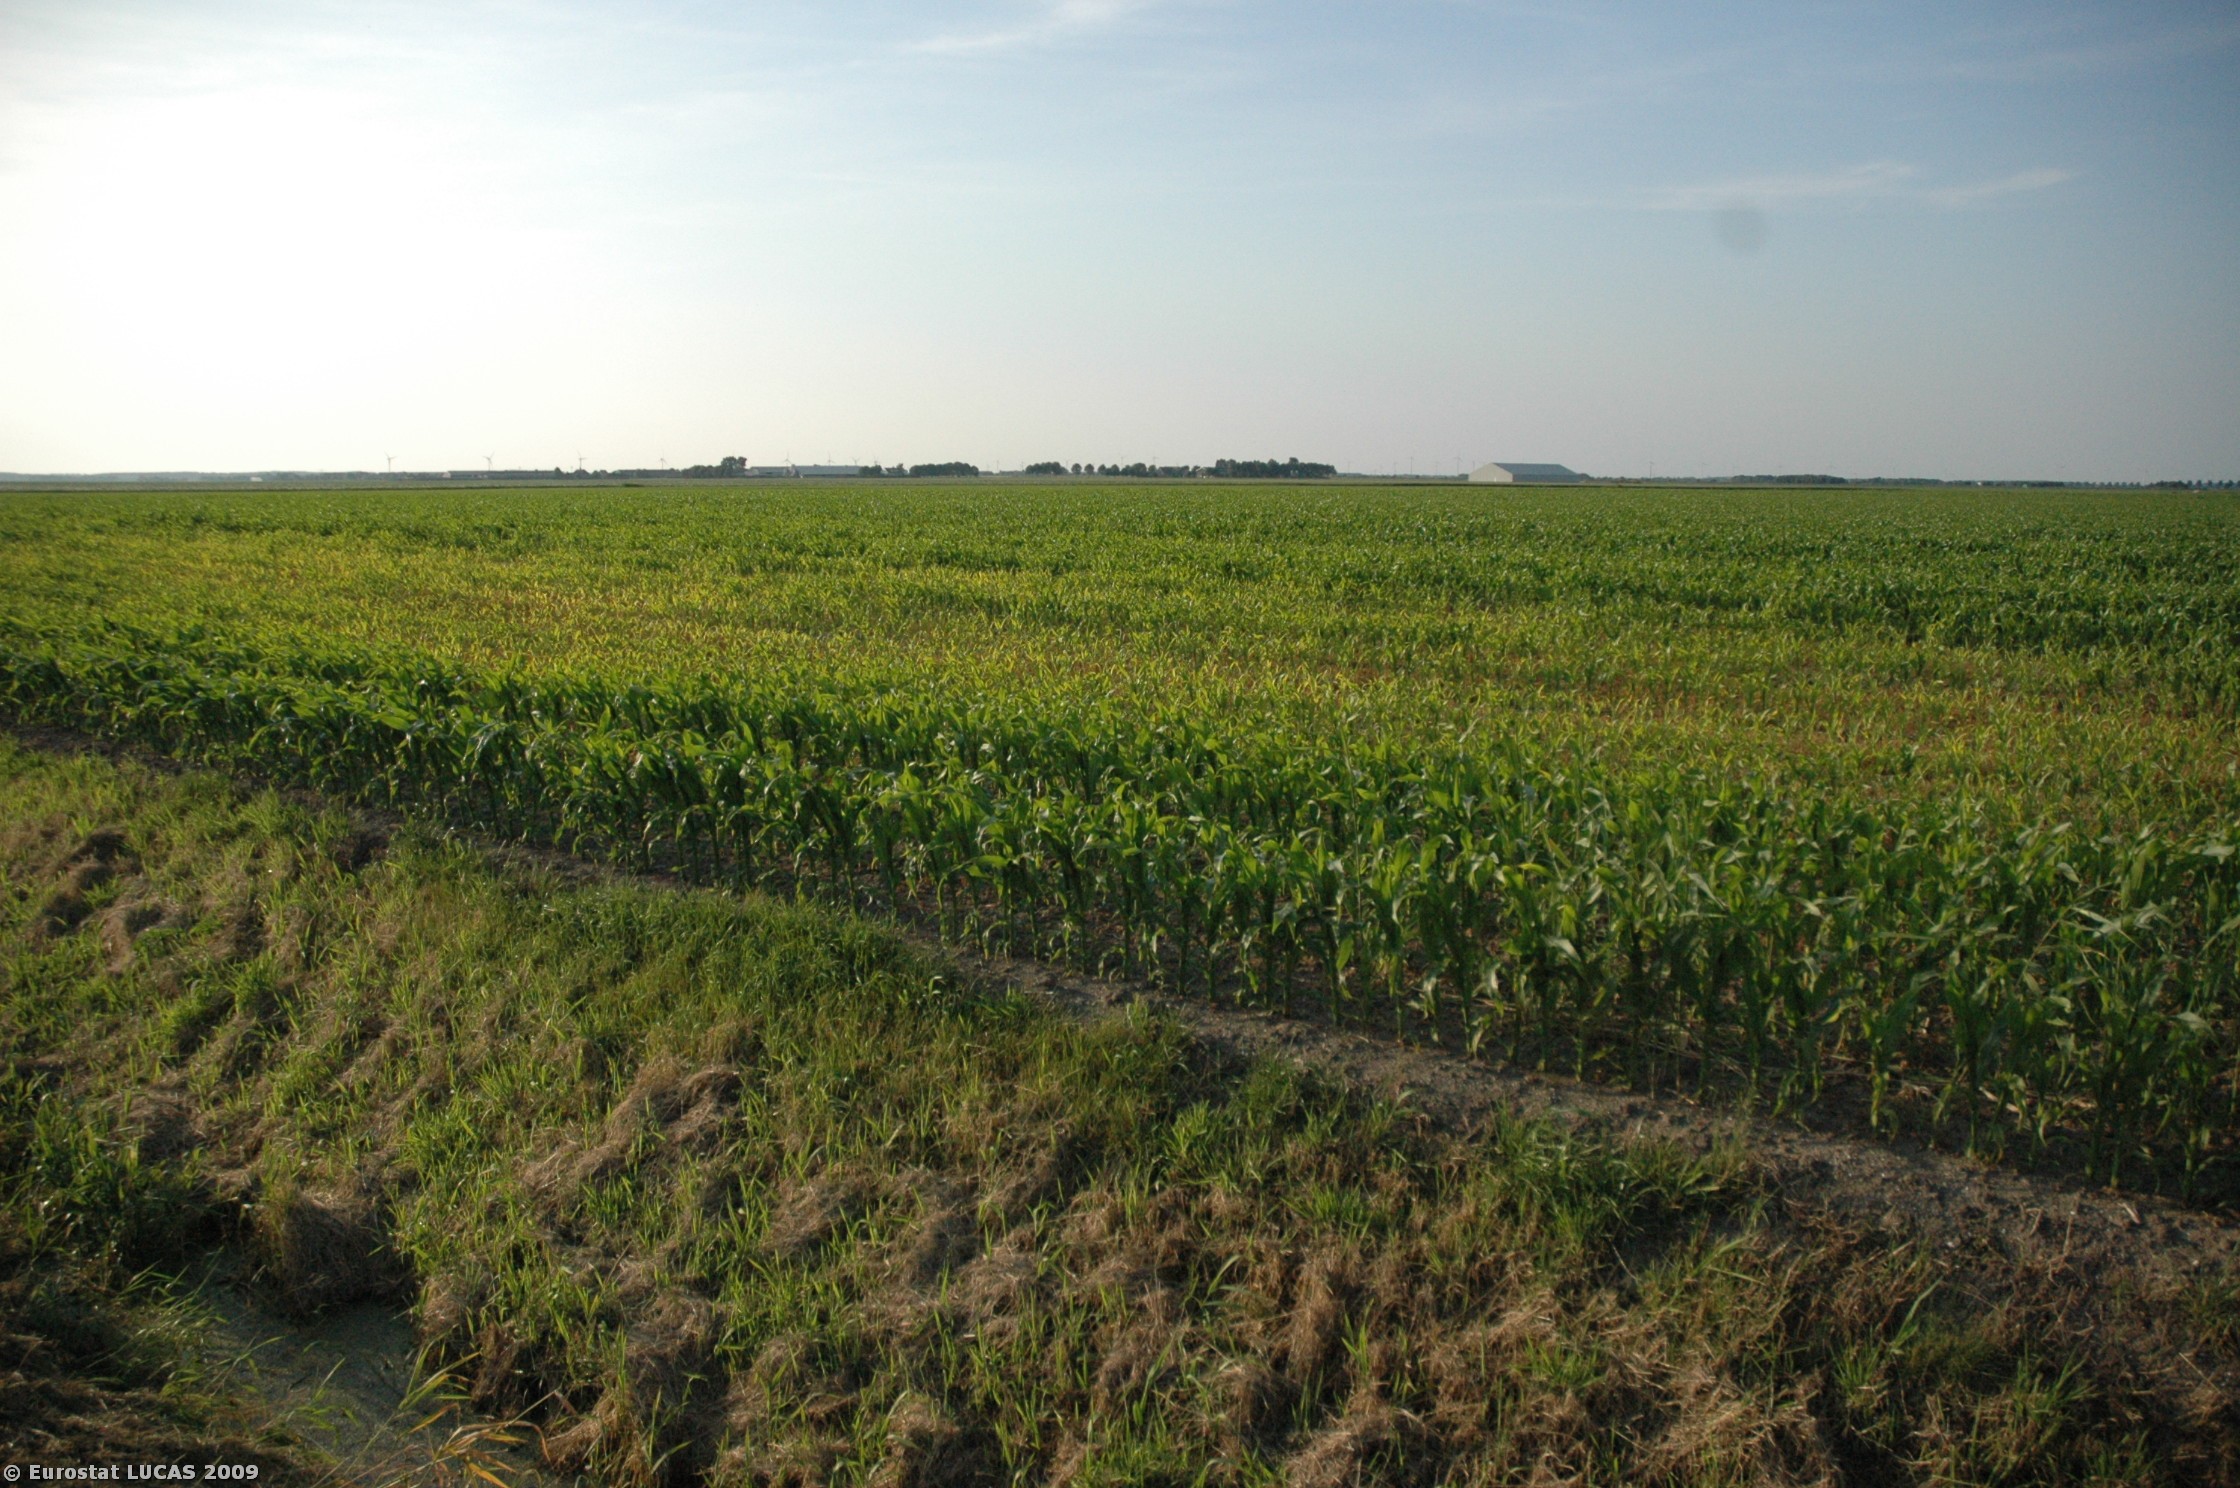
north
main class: Cropland
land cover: Maize
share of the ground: > 75 %
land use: Agriculture (excluding fallow land and kitchen gardens)
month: June
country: NL
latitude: 52.2697
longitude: 5.3821
